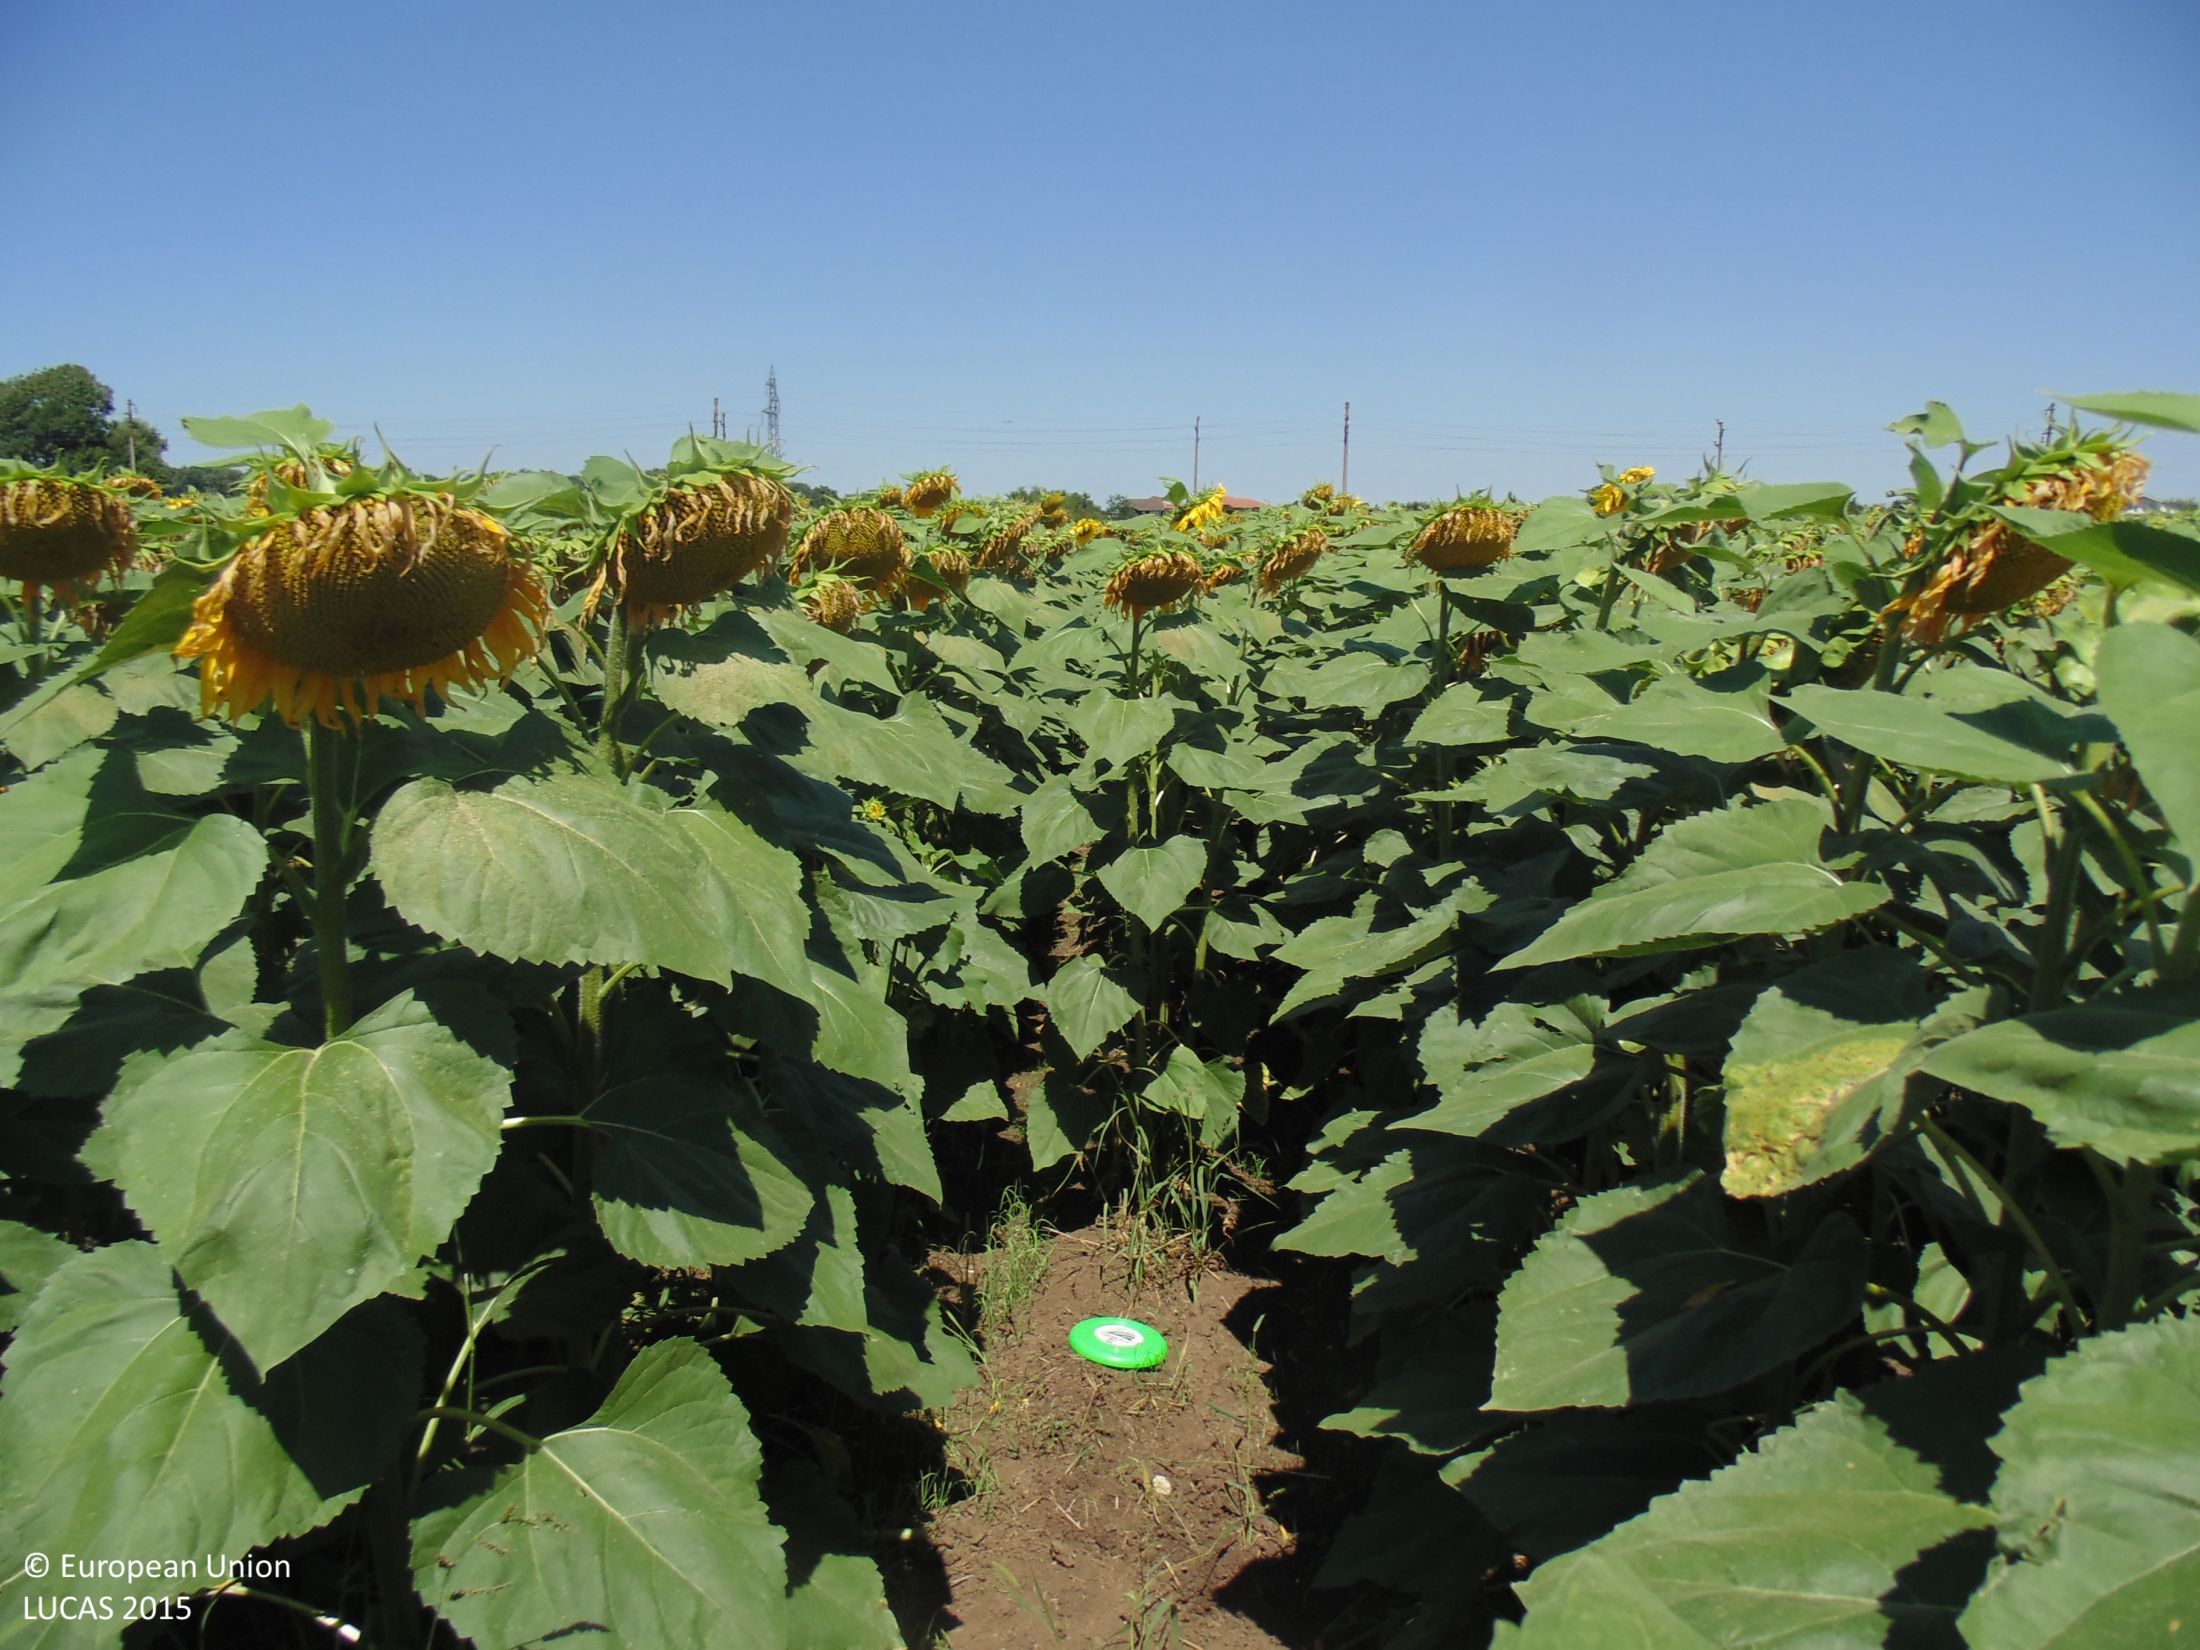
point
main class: Cropland
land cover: Sunflower
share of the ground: > 75 %
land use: Agriculture (excluding fallow land and kitchen gardens)
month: July
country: BG
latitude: 43.4478
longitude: 28.1789
